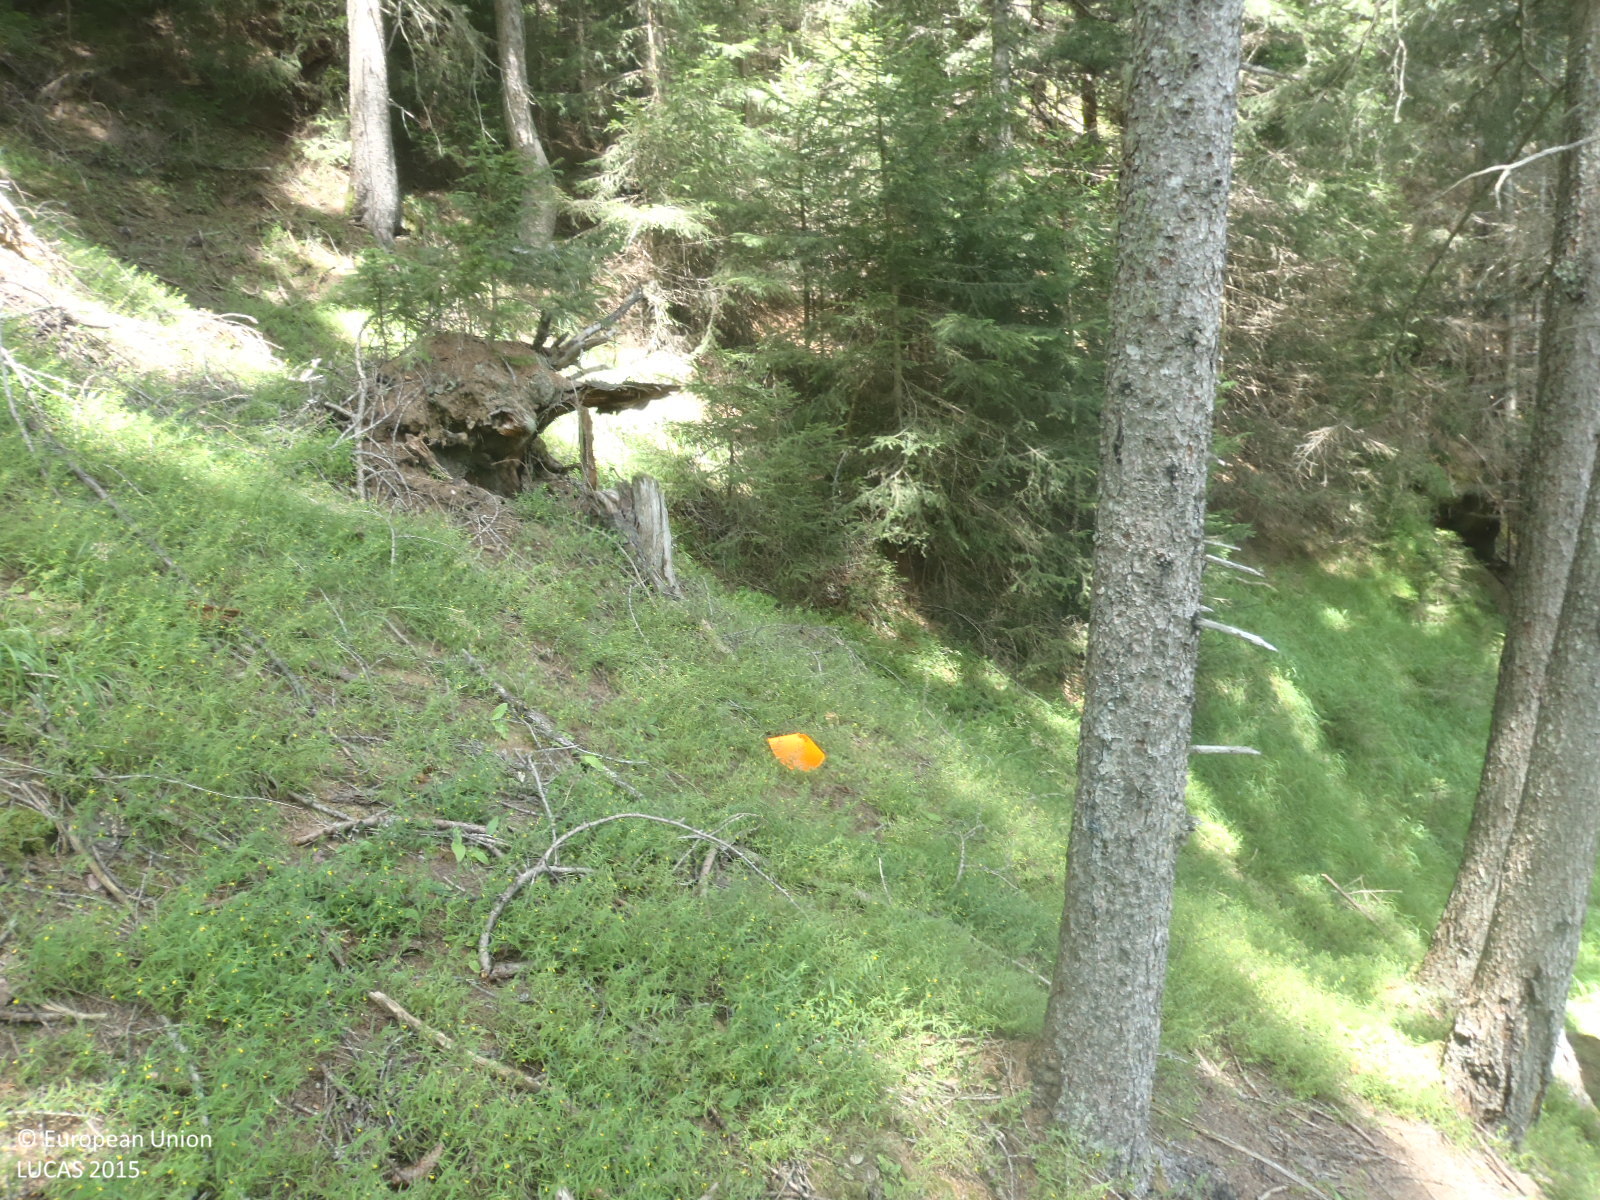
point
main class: Woodland
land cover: Spruce dominated coniferous woodland
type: alpine coniferous forest
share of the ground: > 75 %
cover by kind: coniferous forest trees 90 %, herbaceous plants 10 %
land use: Forestry
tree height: > 5 m
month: August
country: AT
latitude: 47.0064
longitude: 12.5100
